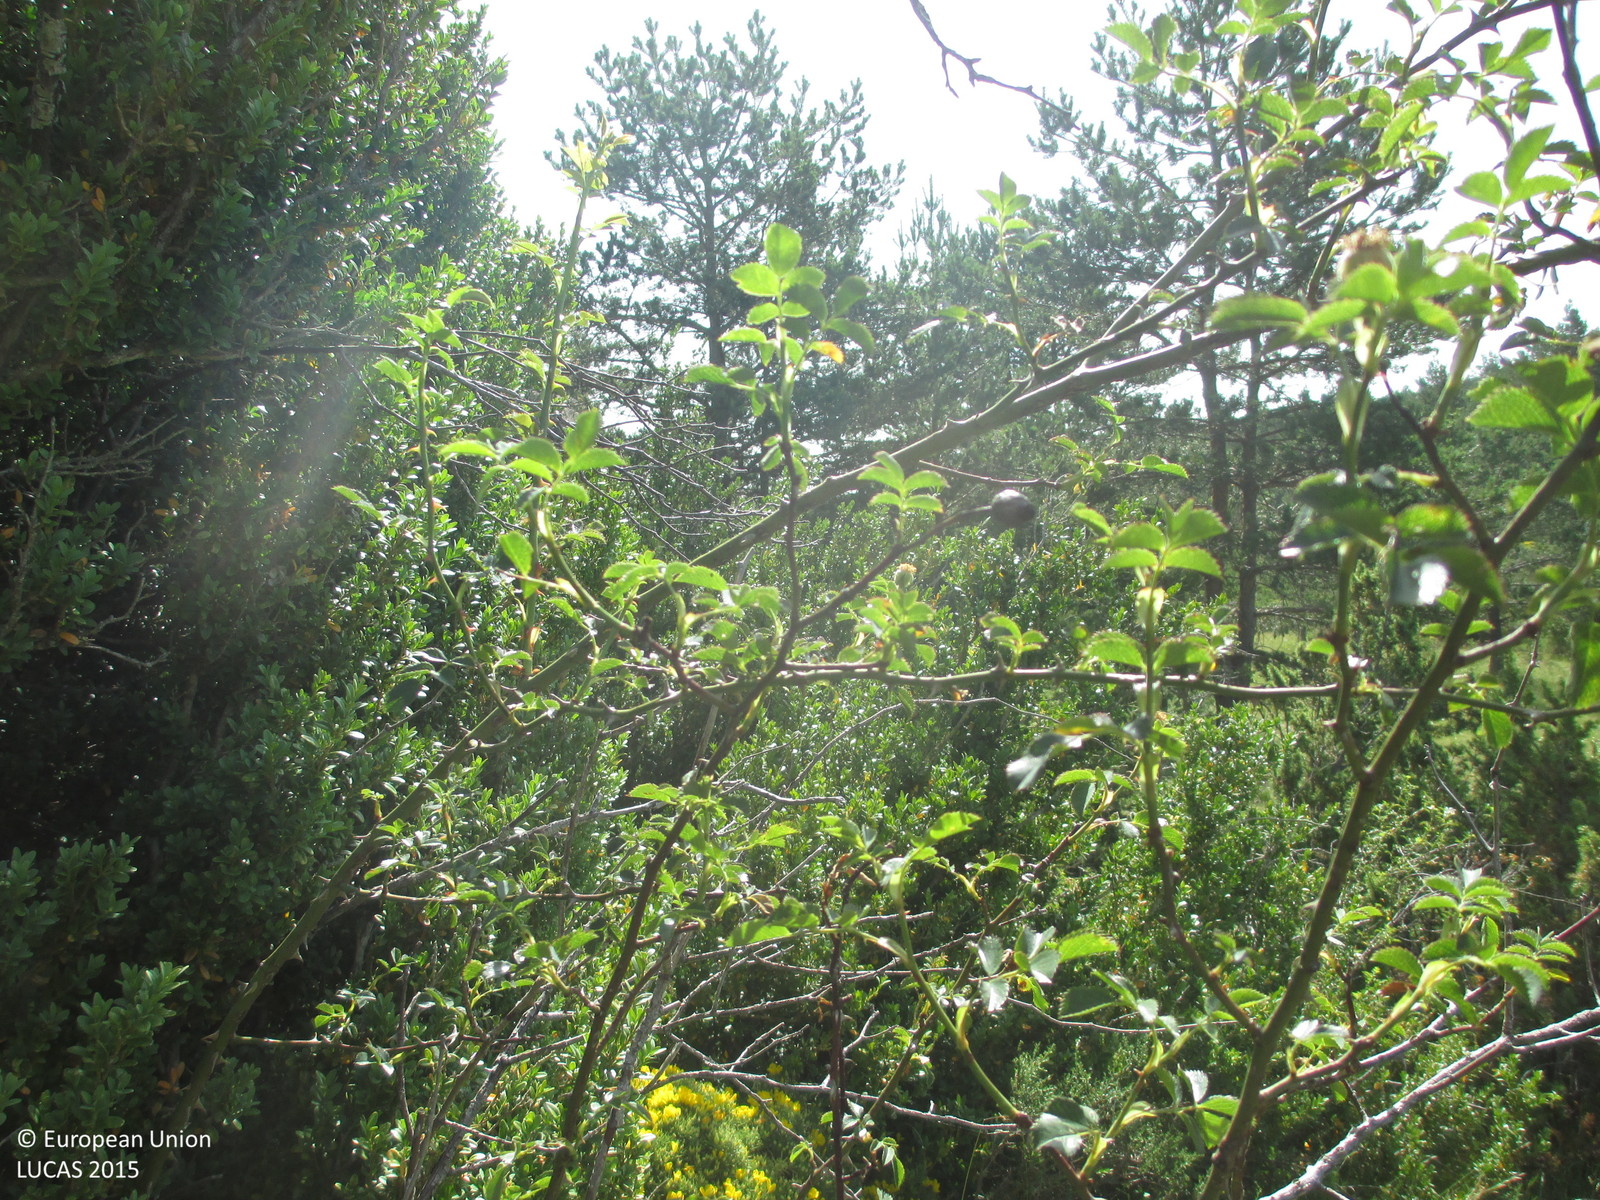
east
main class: Shrubland
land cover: Shrubland with sparse tree cover
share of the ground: > 75 %
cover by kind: shrubs 85 %, coniferous forest trees 5 %, herbaceous plants 5 %, consolidated bare surface 5 %
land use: Semi-natural and natural areas not in use
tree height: > 5 m
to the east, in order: Shrubland with sparse tree cover; Rocks and stones; Shrubland with sparse tree cover
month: July
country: ES
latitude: 42.3558
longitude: -0.3801
